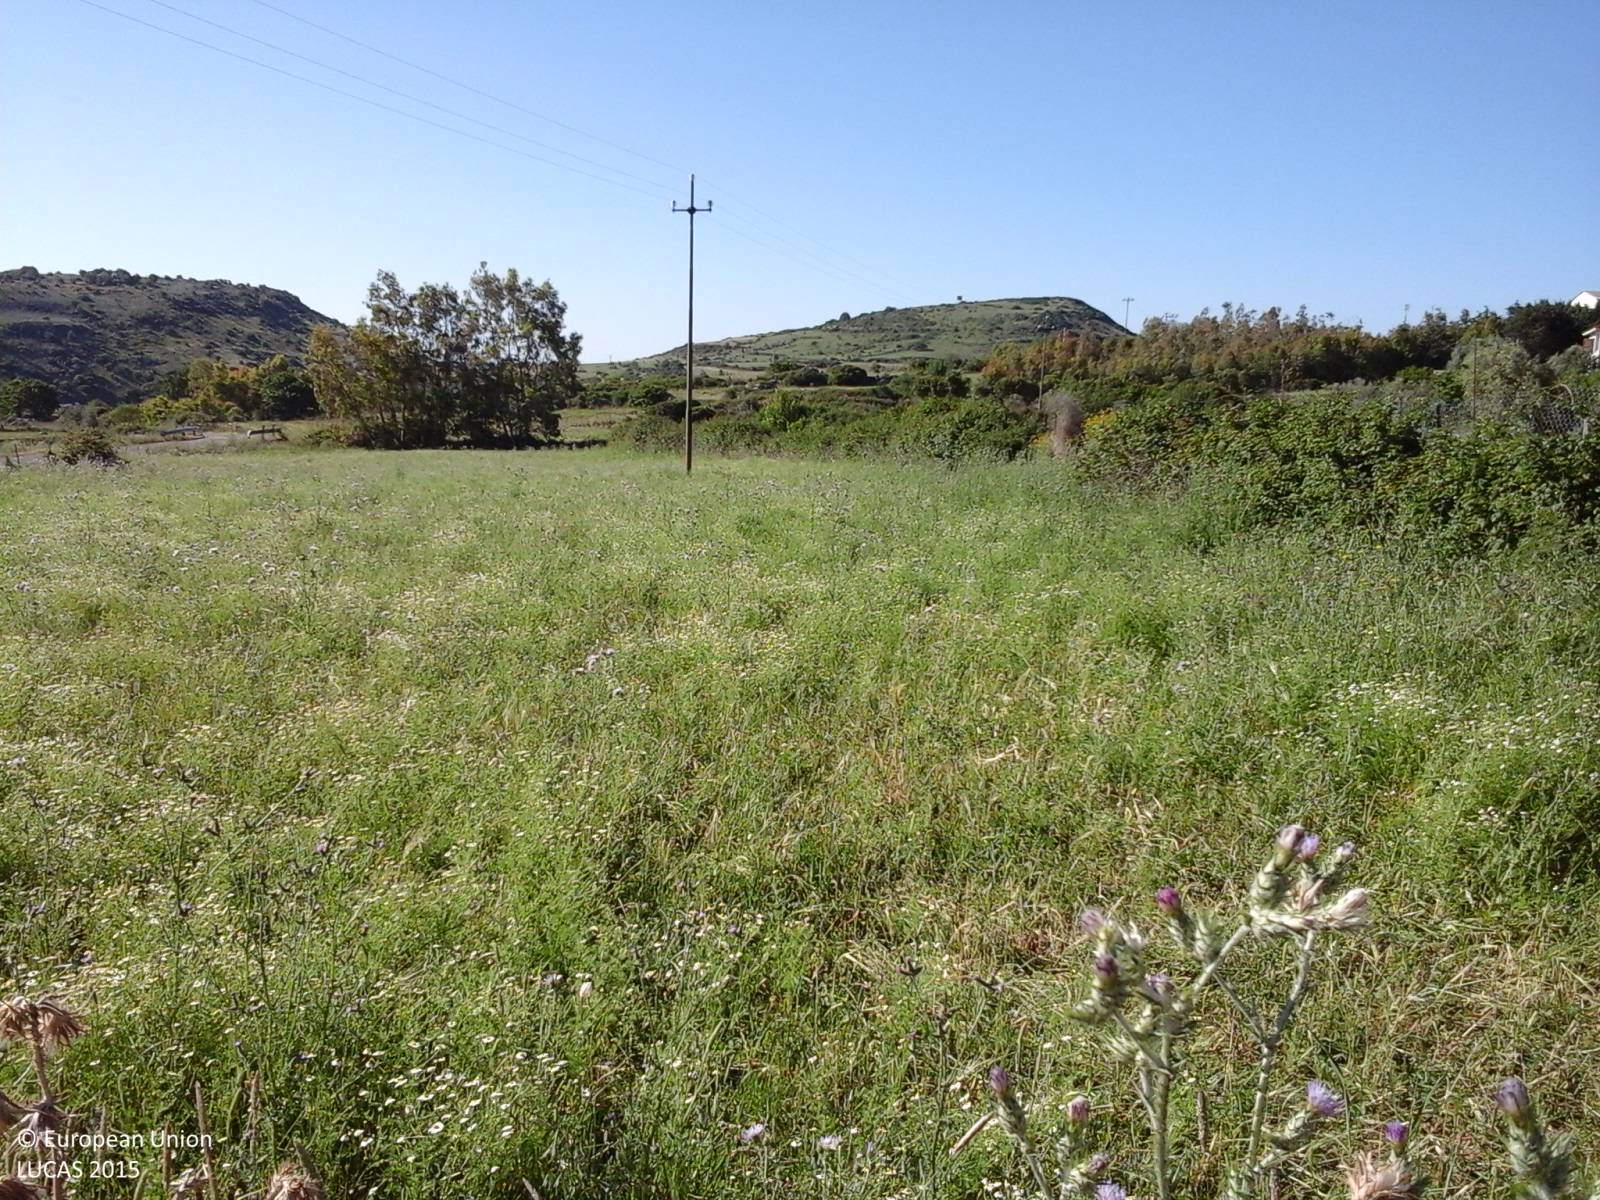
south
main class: Cropland
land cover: Temporary grasslands
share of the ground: > 75 %
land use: Agriculture (excluding fallow land and kitchen gardens)
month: May
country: IT
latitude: 39.7892
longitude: 8.8040
